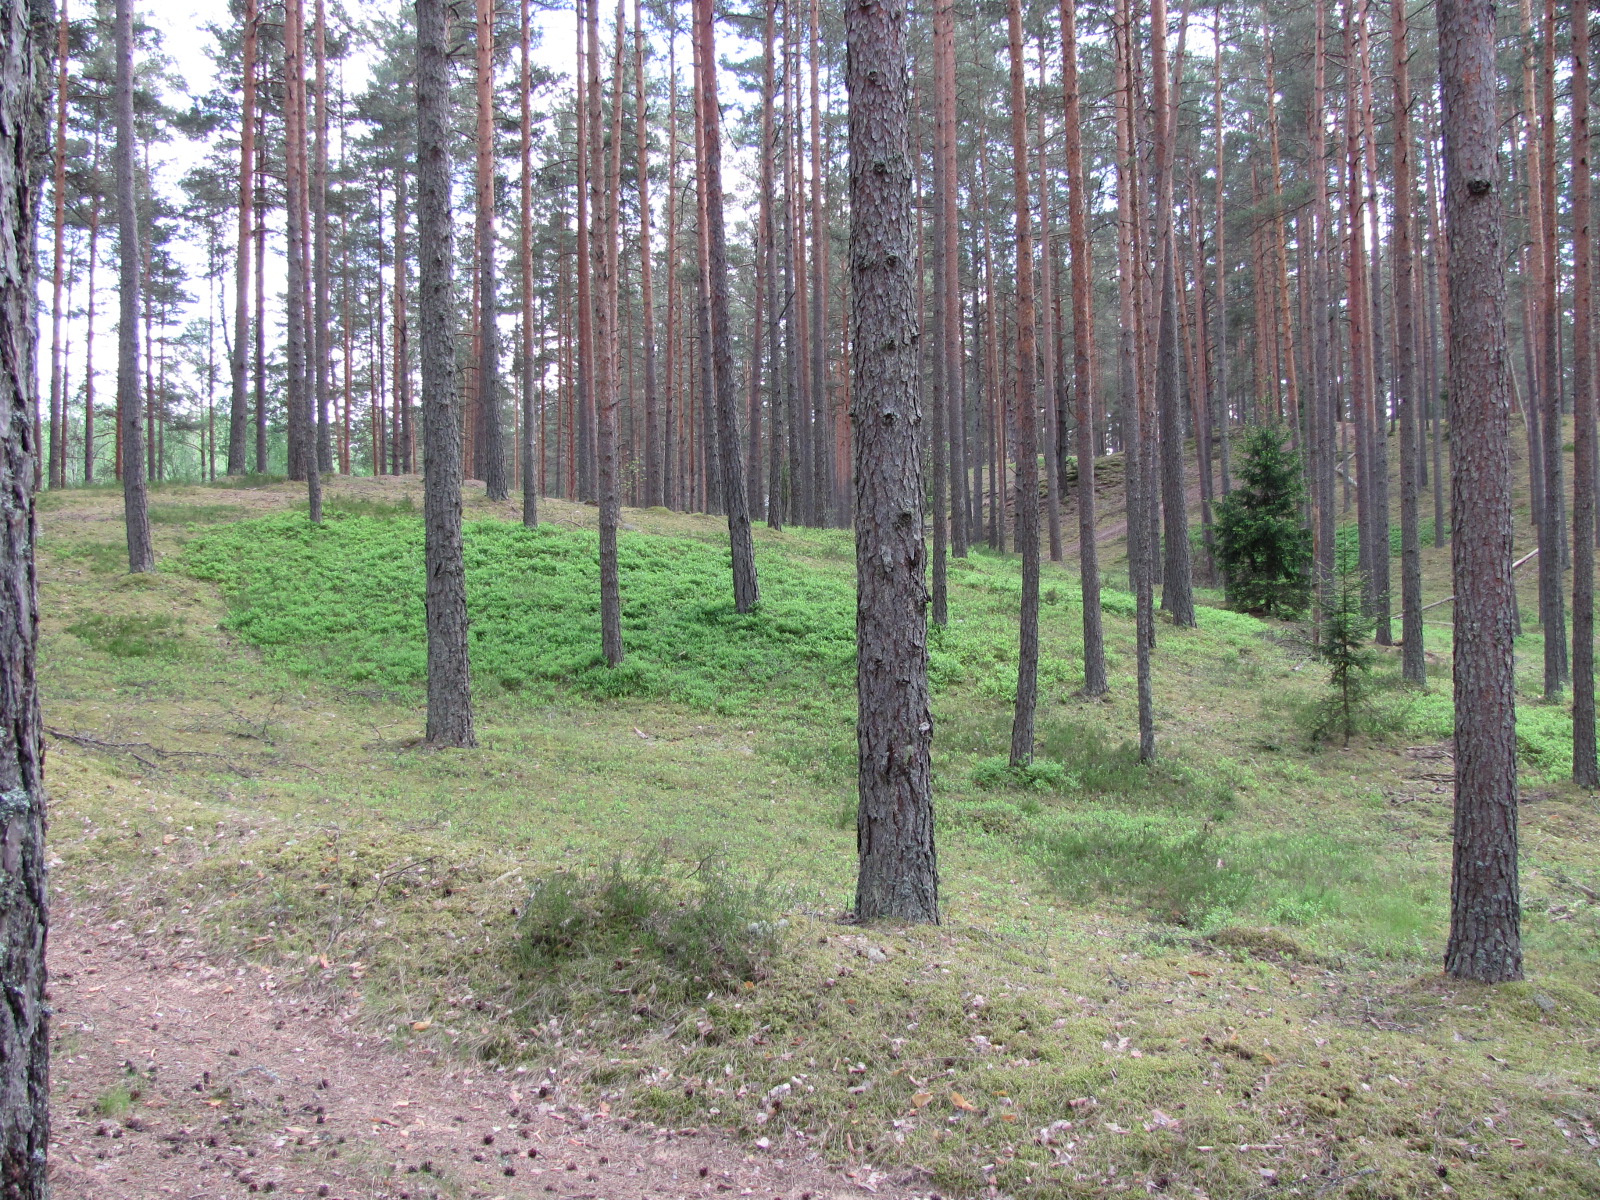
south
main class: Woodland
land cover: Pine dominated coniferous woodland
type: hemiboreal forest and nemoral coniferous forest and mixed broadleaved-coniferous forest
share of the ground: > 75 %
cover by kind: coniferous forest trees 85 %, lichens and mosses 15 %
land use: Forestry
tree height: > 5 m
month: June
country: LV
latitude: 56.9602
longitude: 24.4157
